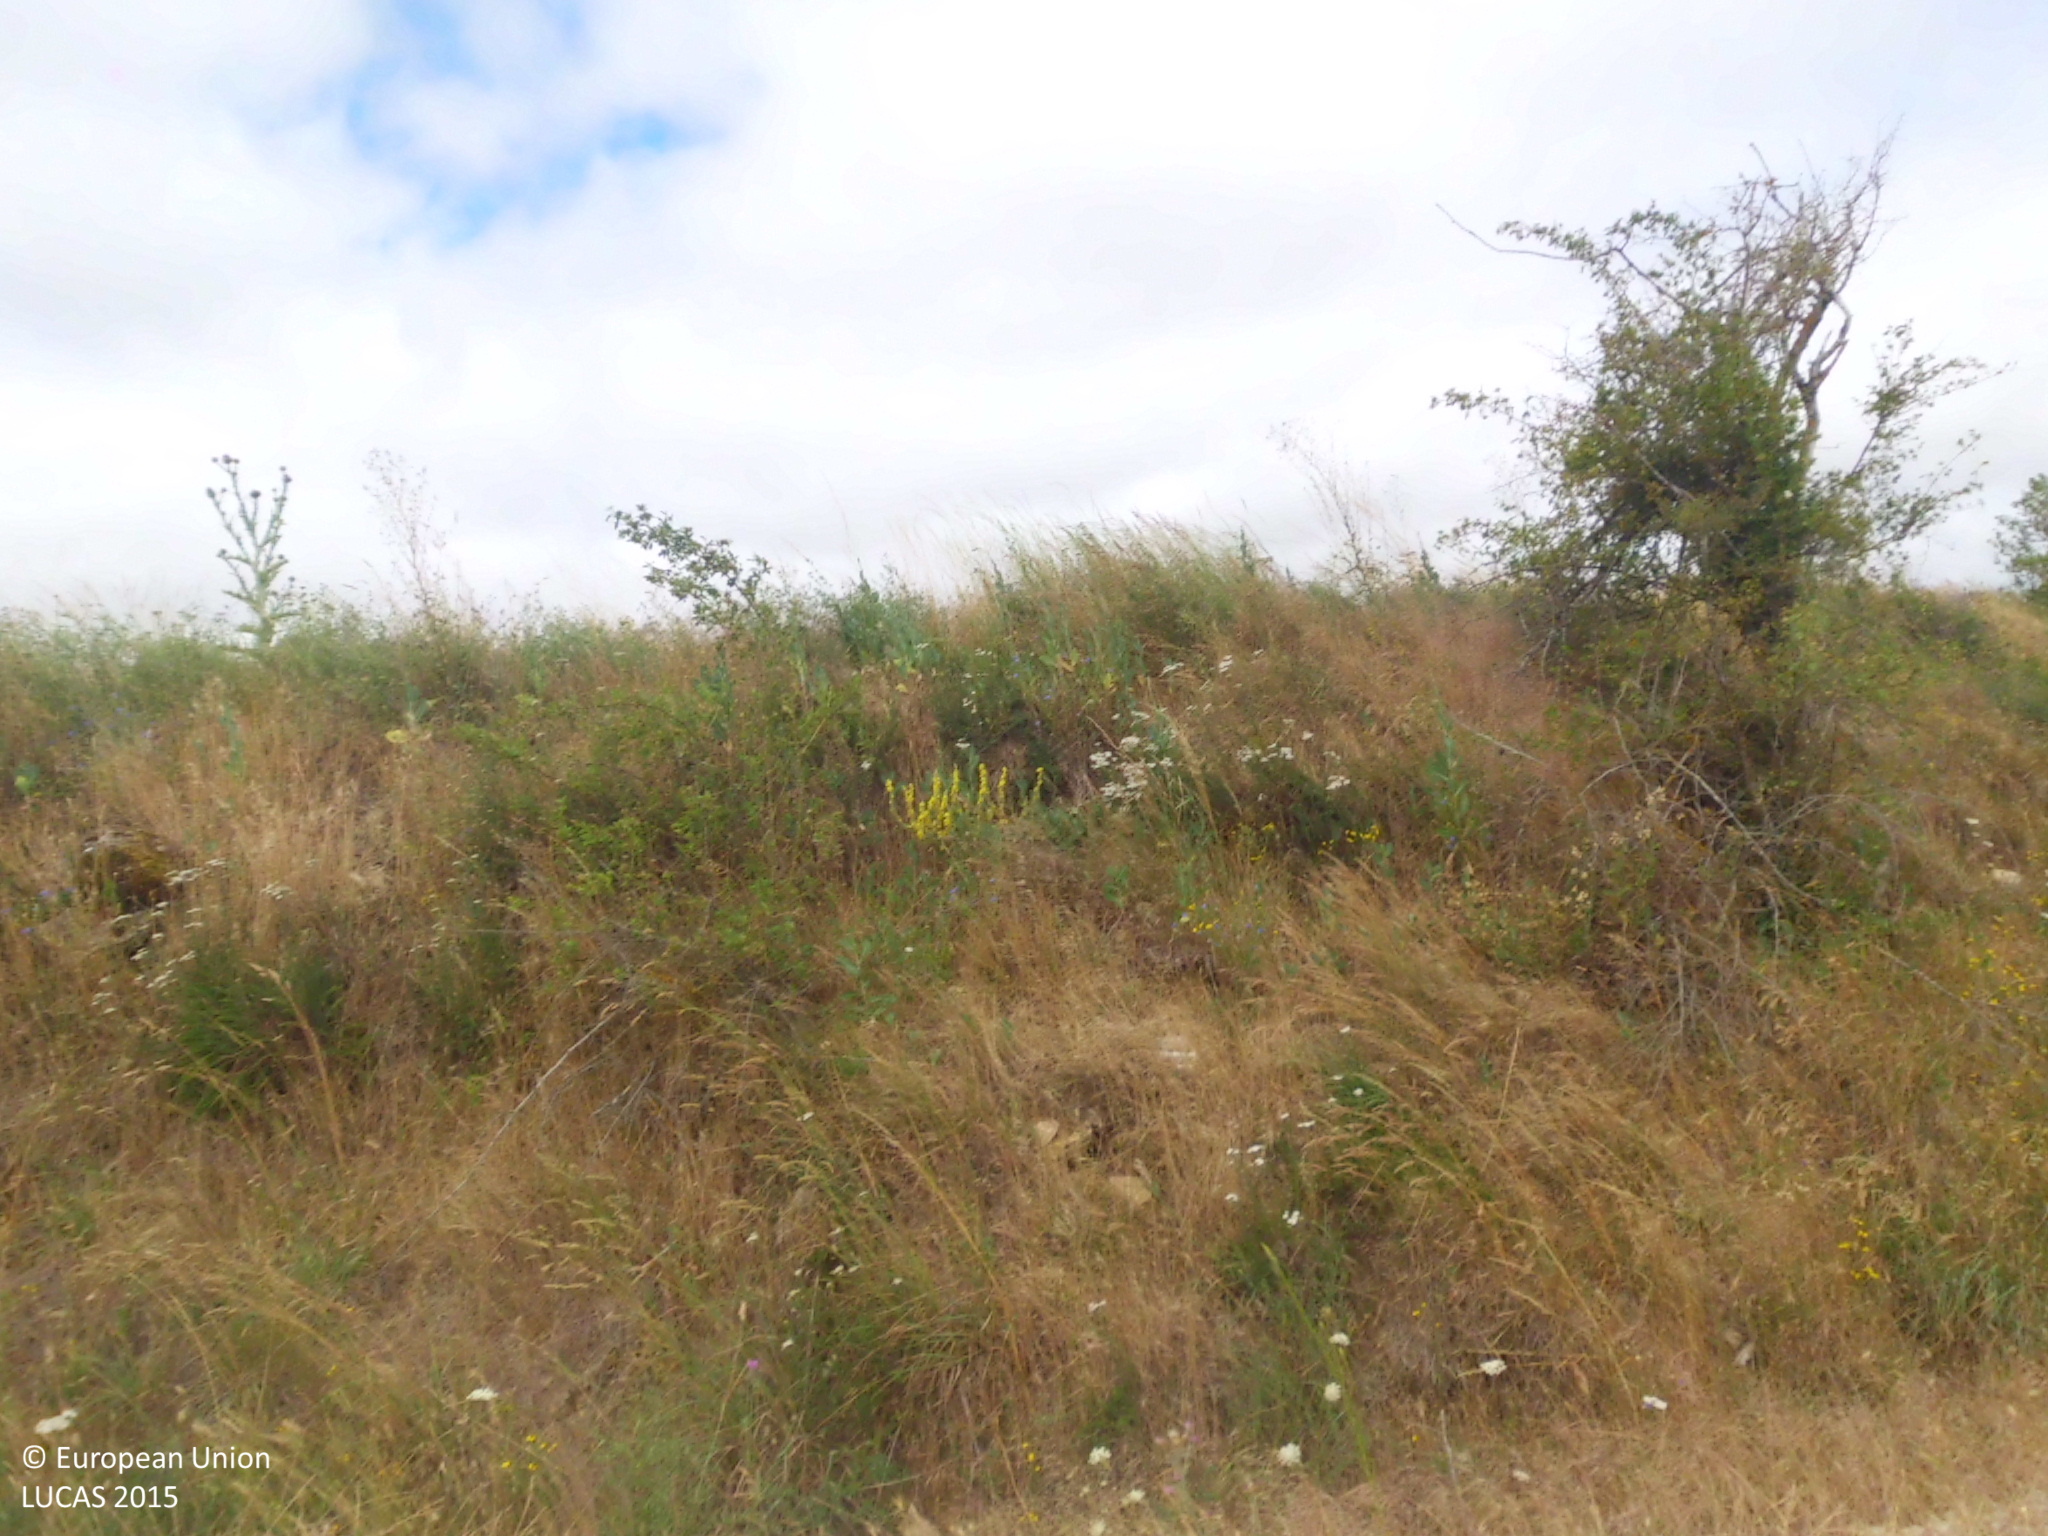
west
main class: Shrubland
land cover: Shrubland with sparse tree cover
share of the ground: 25 - 50 %
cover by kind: herbaceous plants 40 %, consolidated bare surface 30 %, shrubs 25 %, broadleaved forest trees 5 %
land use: Abandoned areas
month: July
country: ES
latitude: 42.7300
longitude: -4.0547
